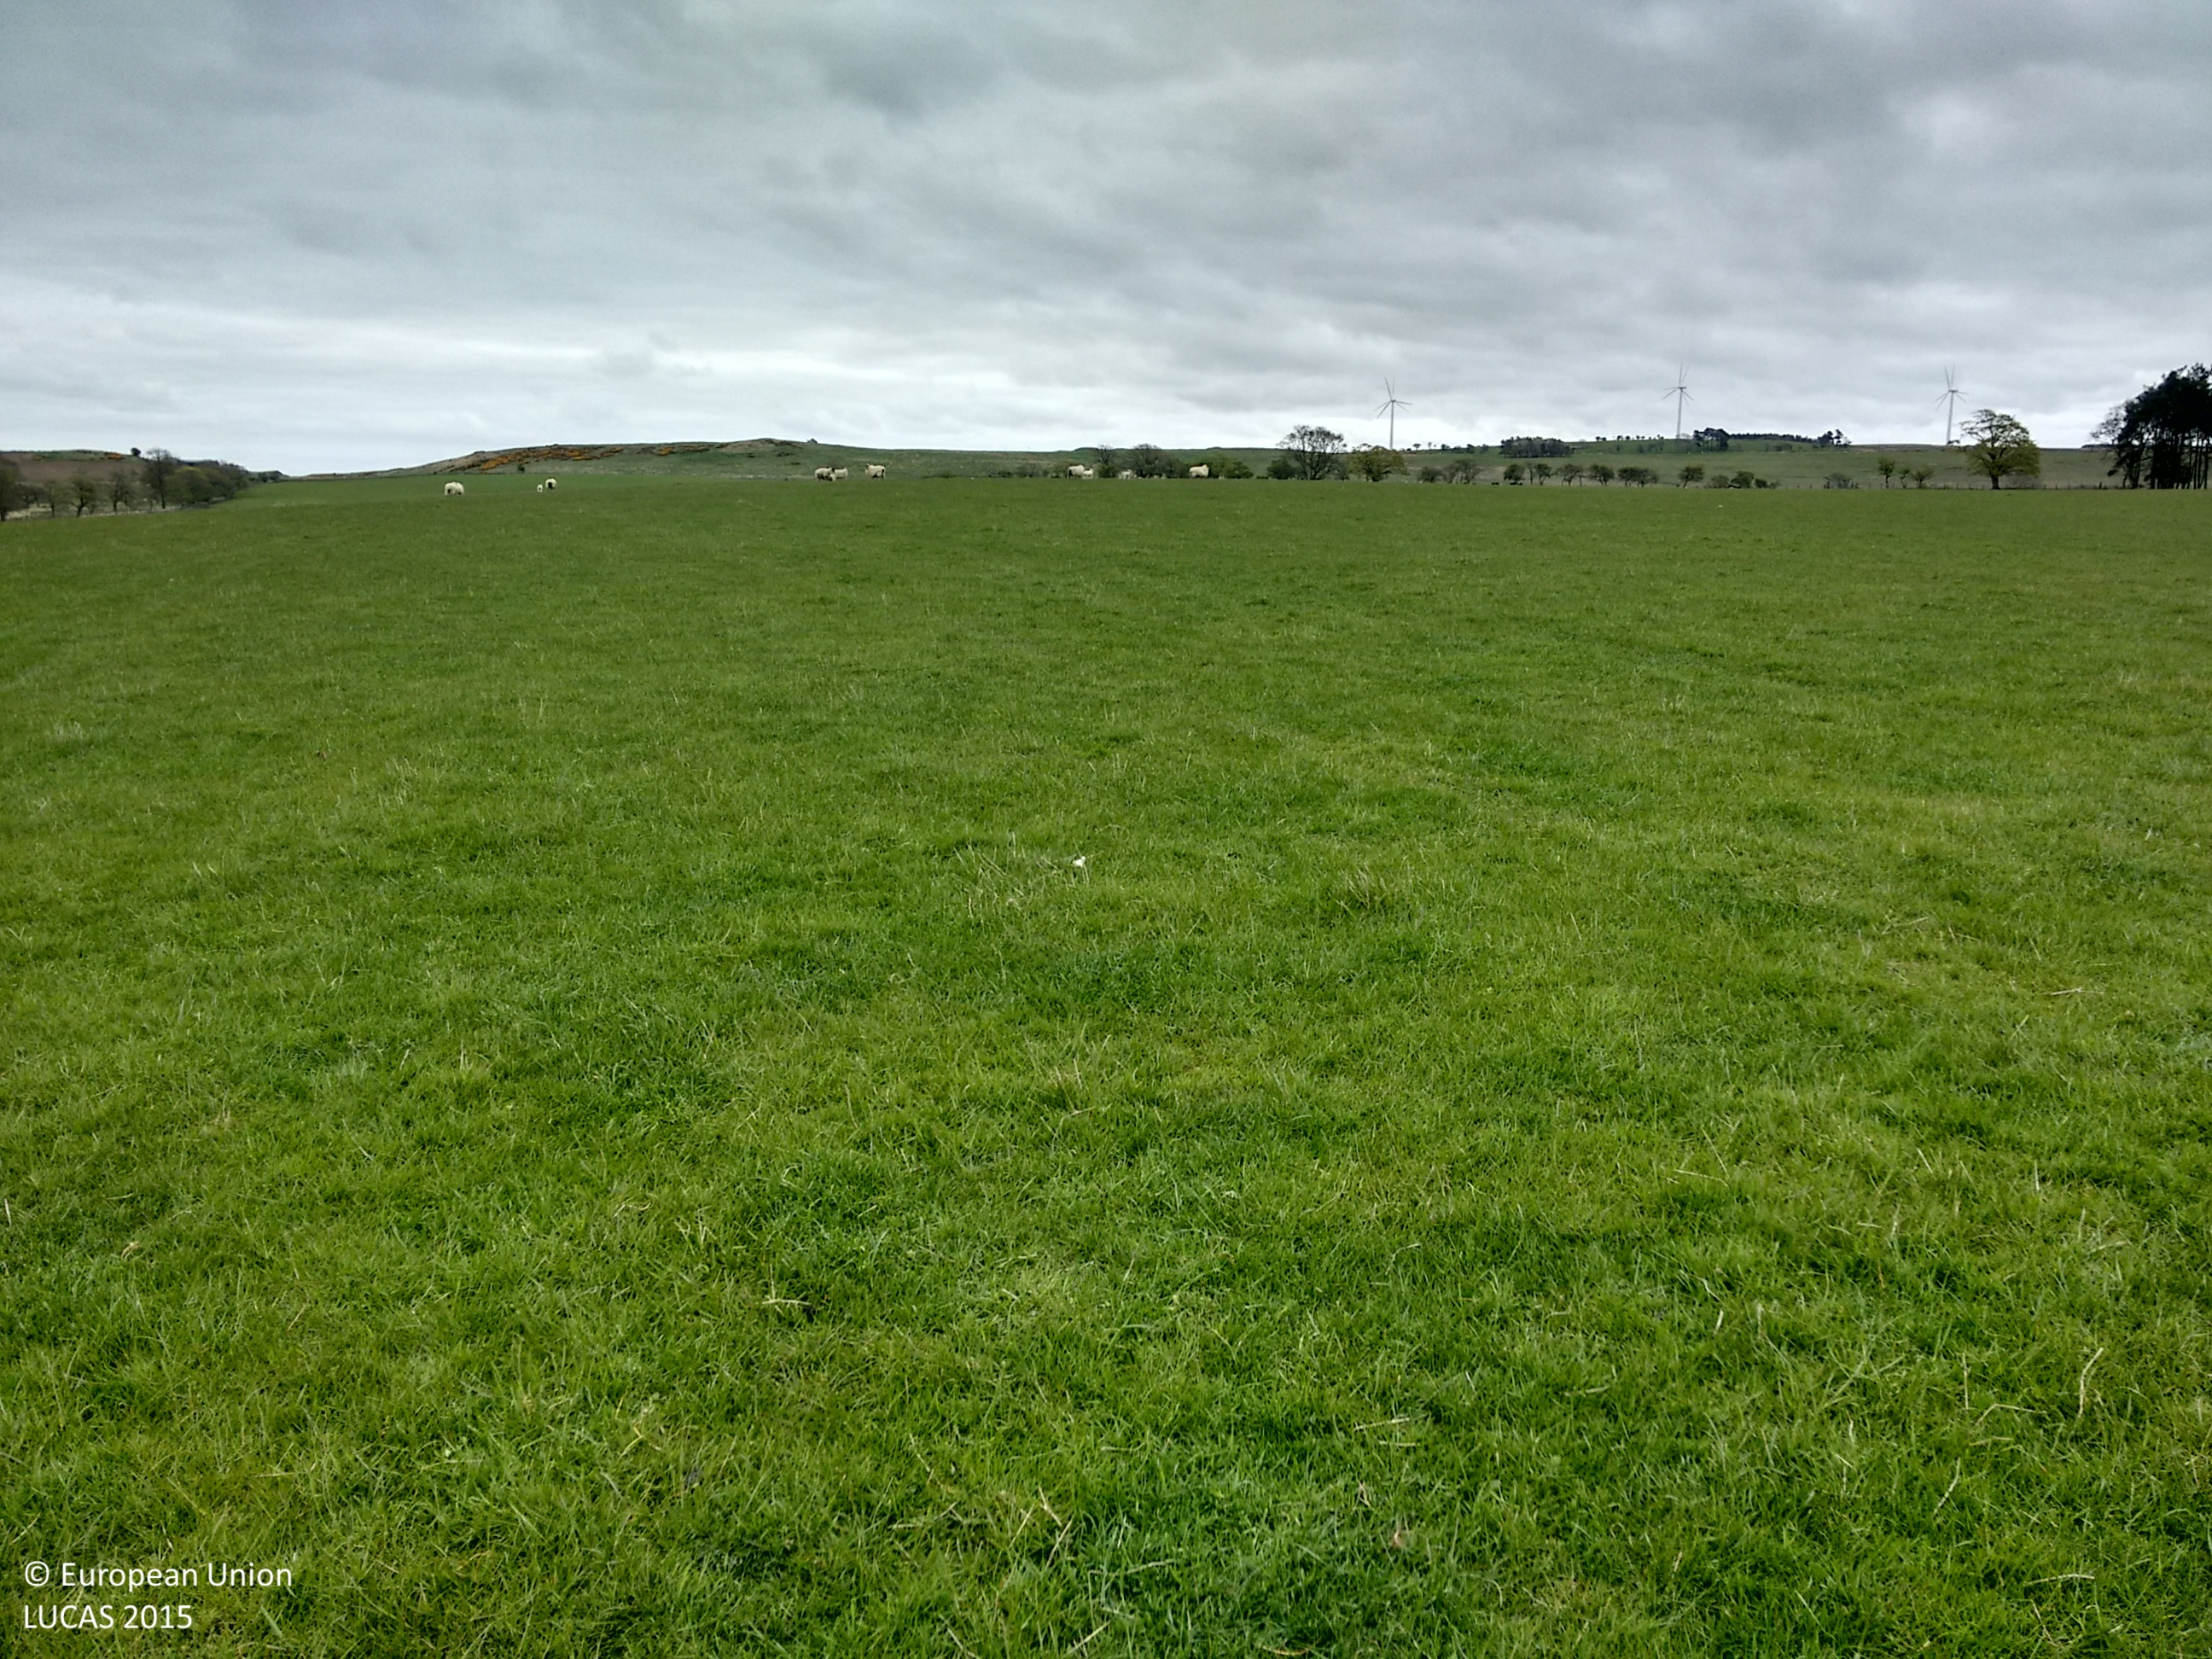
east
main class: Grassland
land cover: Grassland without tree/shrub cover
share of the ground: > 75 %
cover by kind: herbaceous plants 100 %
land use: Agriculture (excluding fallow land and kitchen gardens)
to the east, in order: Grassland without tree/shrub cover; Fences; Grassland without tree/shrub cover
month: May
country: GB
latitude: 55.0935
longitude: -2.0103
